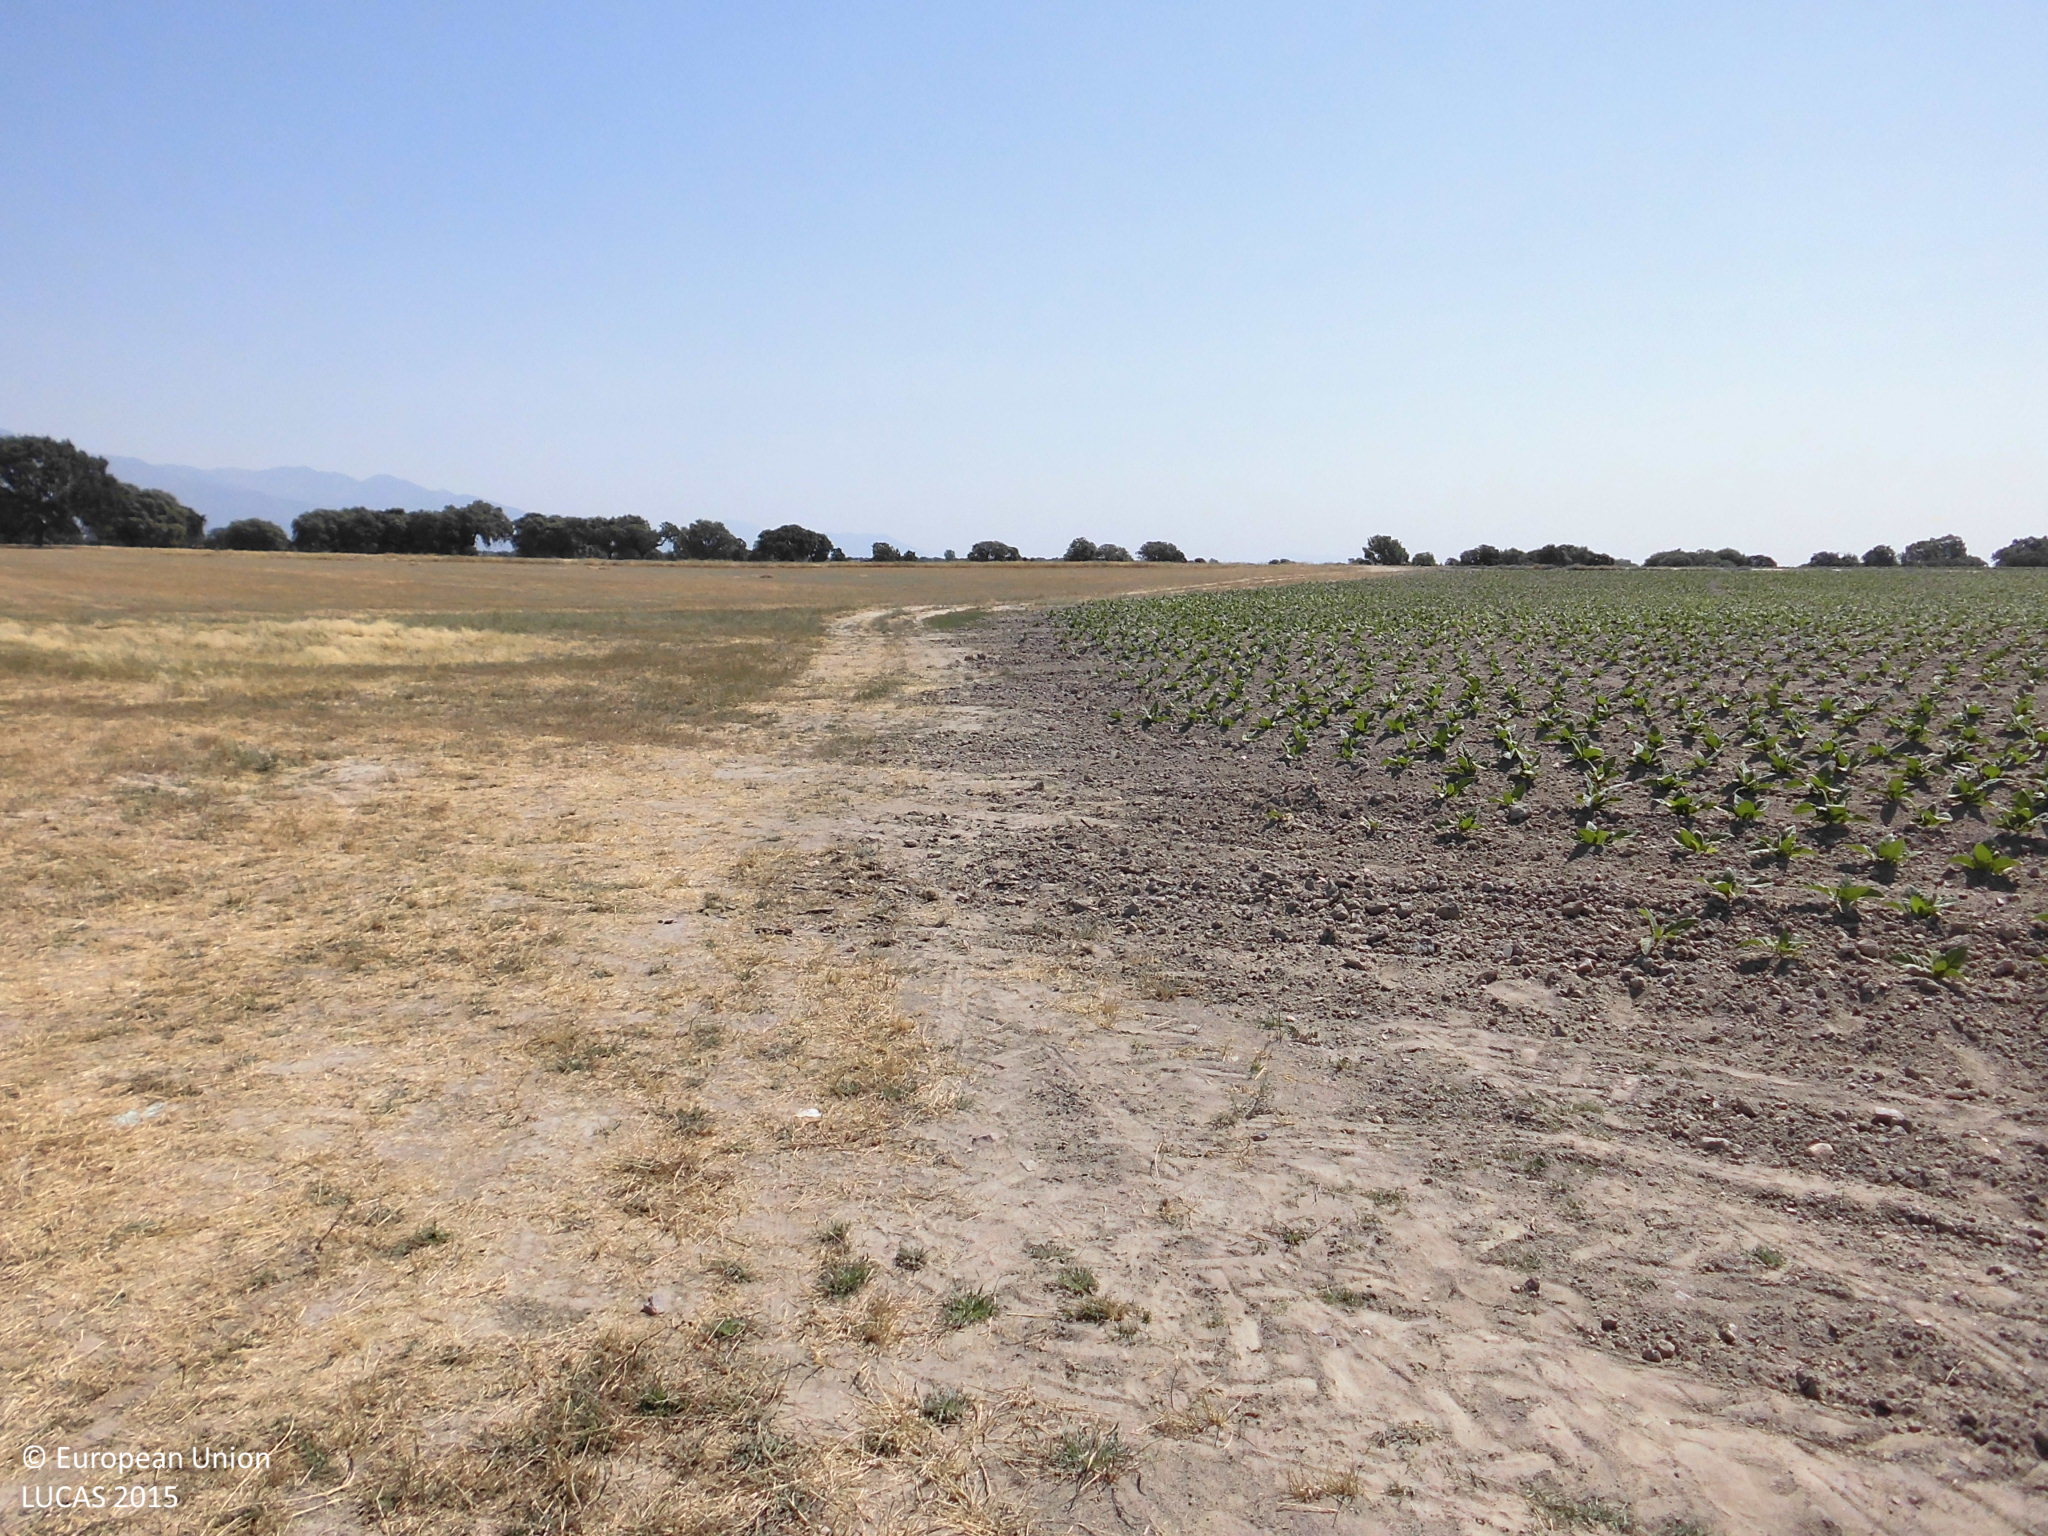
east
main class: Woodland
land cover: Broadleaved woodland
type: broadleaved evergreen forest
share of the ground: 10 - 25 %
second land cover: Grassland without tree/shrub cover
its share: > 75 %
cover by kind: herbaceous plants 85 %, broadleaved forest trees 10 %, unconsolidated bare surface 5 %
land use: Forestry
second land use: Agriculture (excluding fallow land and kitchen gardens)
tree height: > 5 m
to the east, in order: Broadleaved woodland; Grassland without tree/shrub cover; Tracks; Broadleaved woodland; Fences; Arable land (only in case pi); Fences; Electric lines; Arable land (only in case pi); Rivers and streams; Arable land (only in case pi)
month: June
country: ES
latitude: 40.0035
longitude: -5.4868
